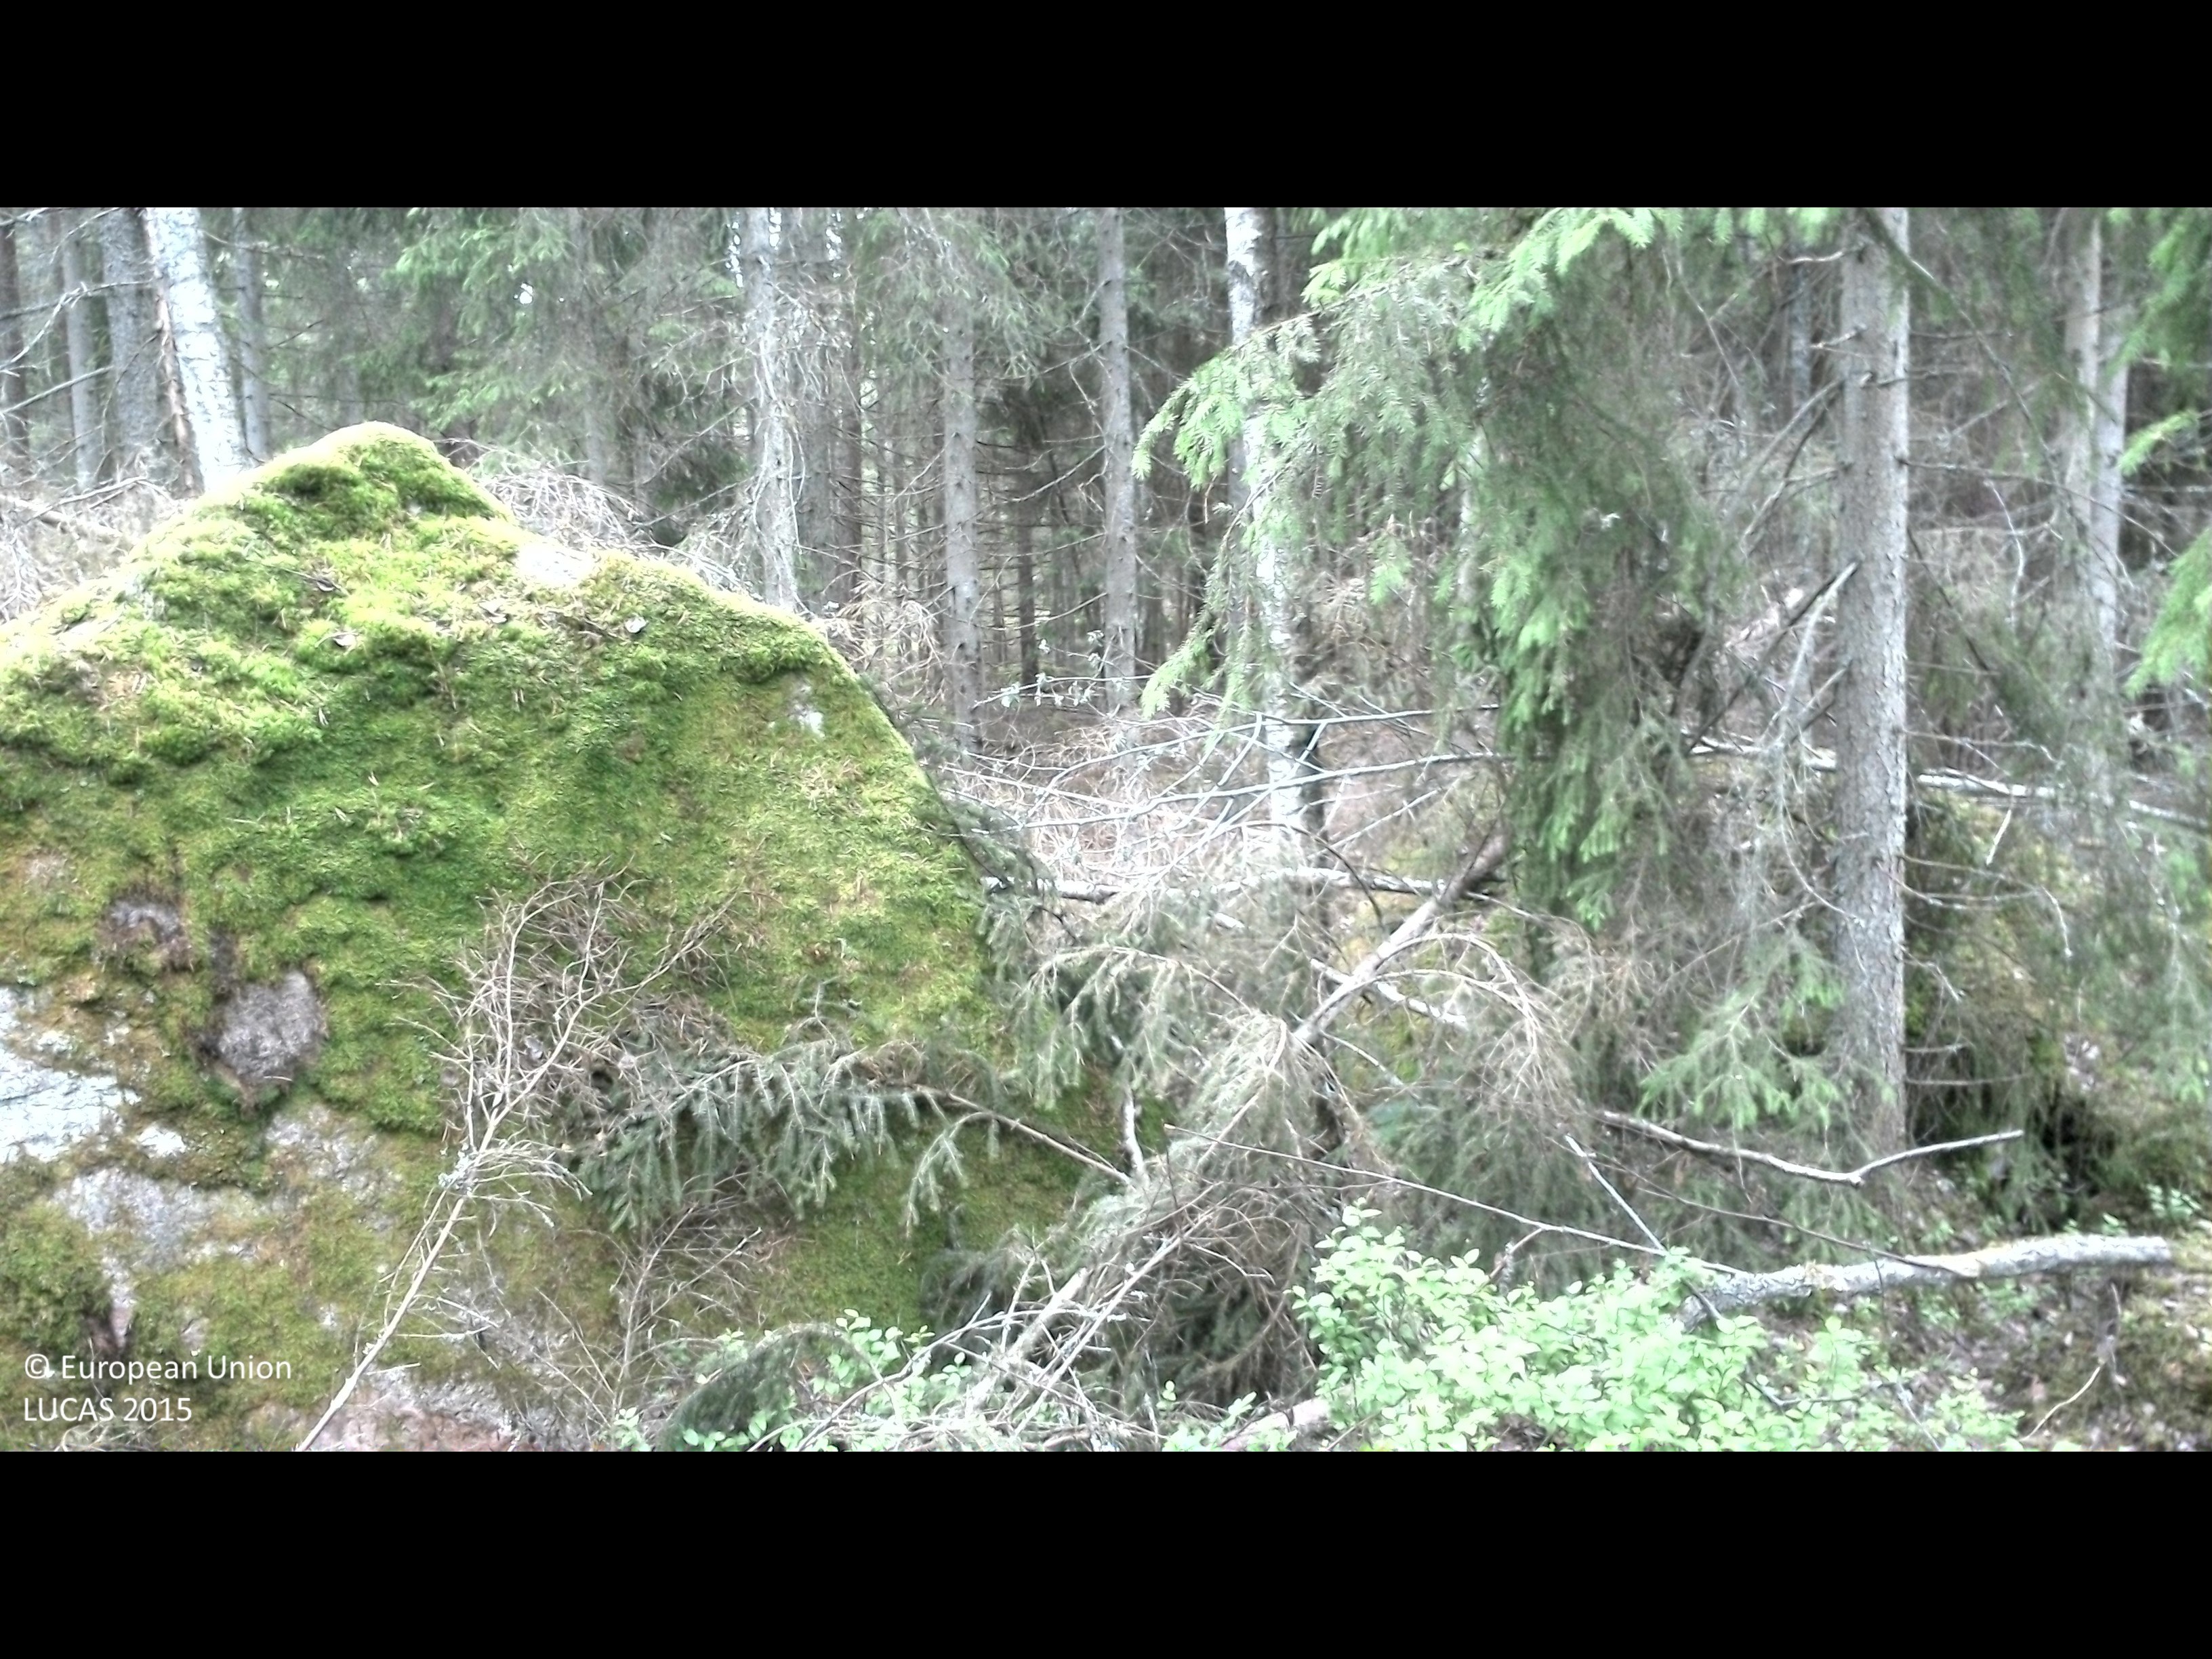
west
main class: Woodland
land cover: Pine dominated coniferous woodland
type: boreal forest
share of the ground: 50 - 75 %
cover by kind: coniferous forest trees 75 %, shrubs 15 %, broadleaved forest trees 5 %, lichens and mosses 5 %
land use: Forestry
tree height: > 5 m
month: June
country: SE
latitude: 56.4672
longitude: 15.8920
